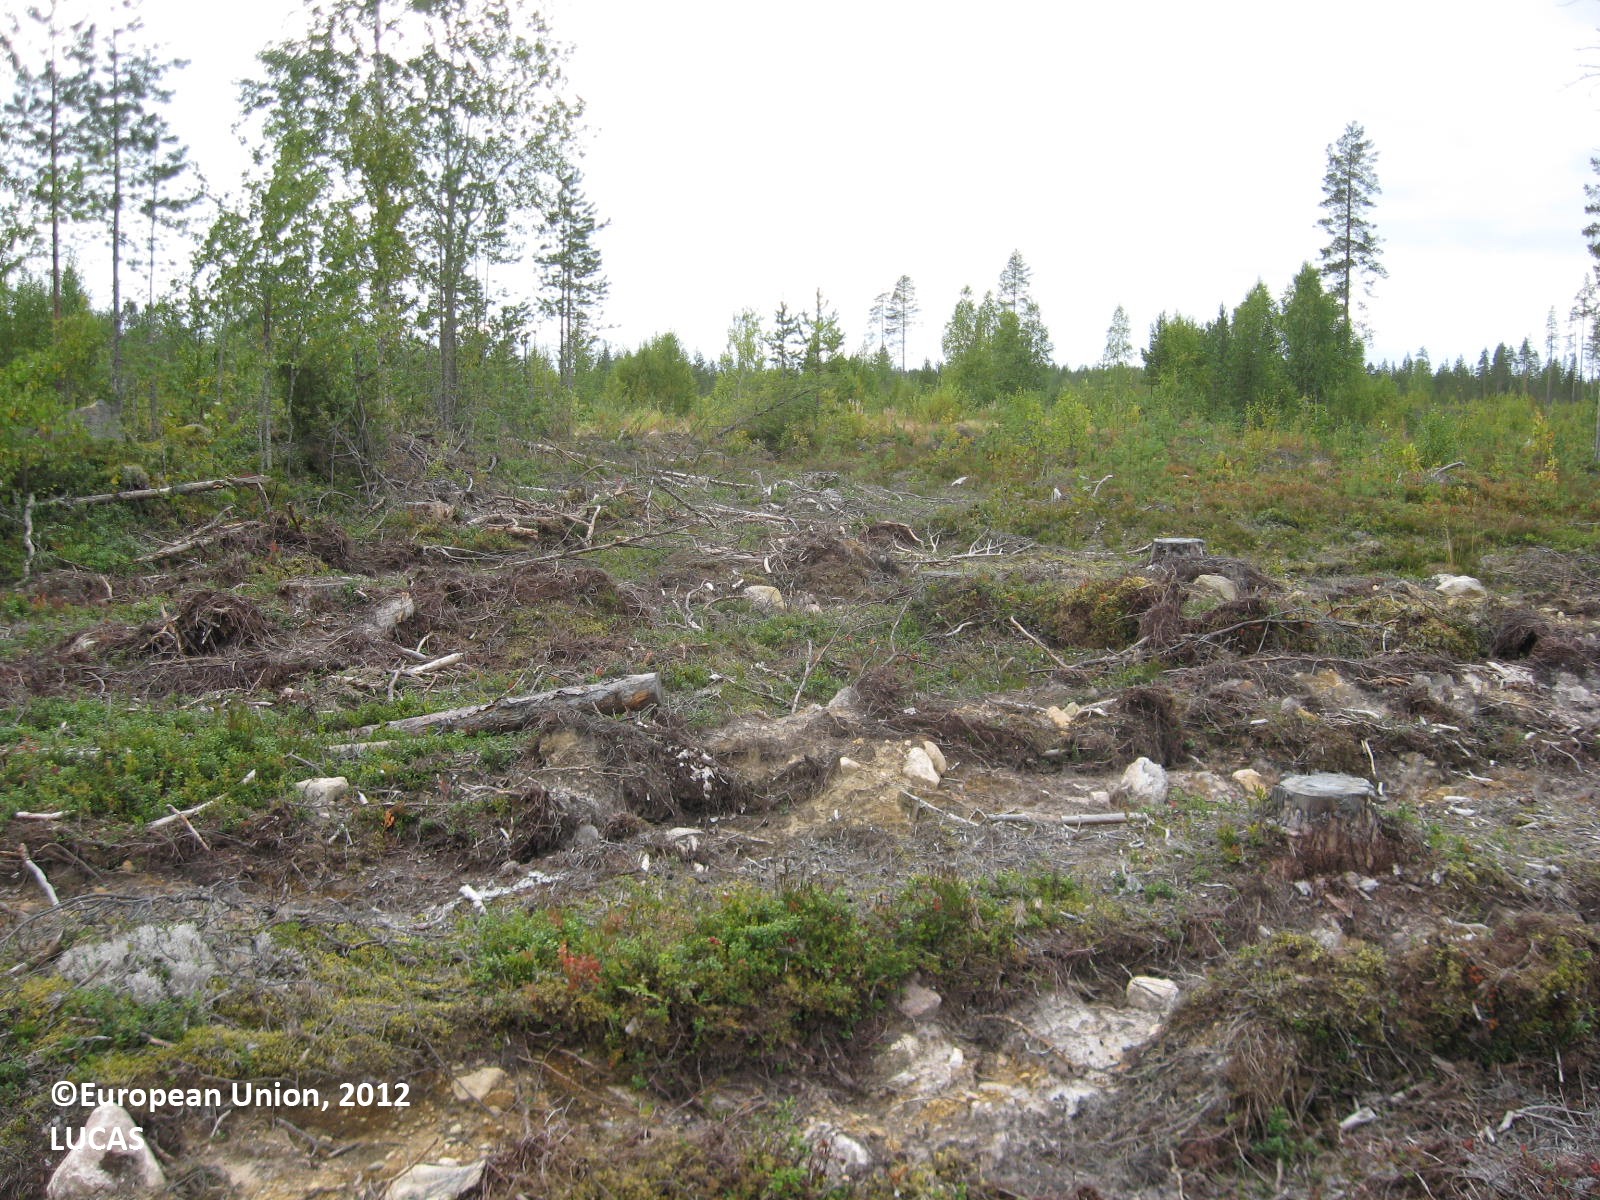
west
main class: Grassland
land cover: Grassland without tree/shrub cover
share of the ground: > 75 %
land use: Forestry
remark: Clear cut
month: August
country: FI
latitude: 63.9707
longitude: 29.2252
